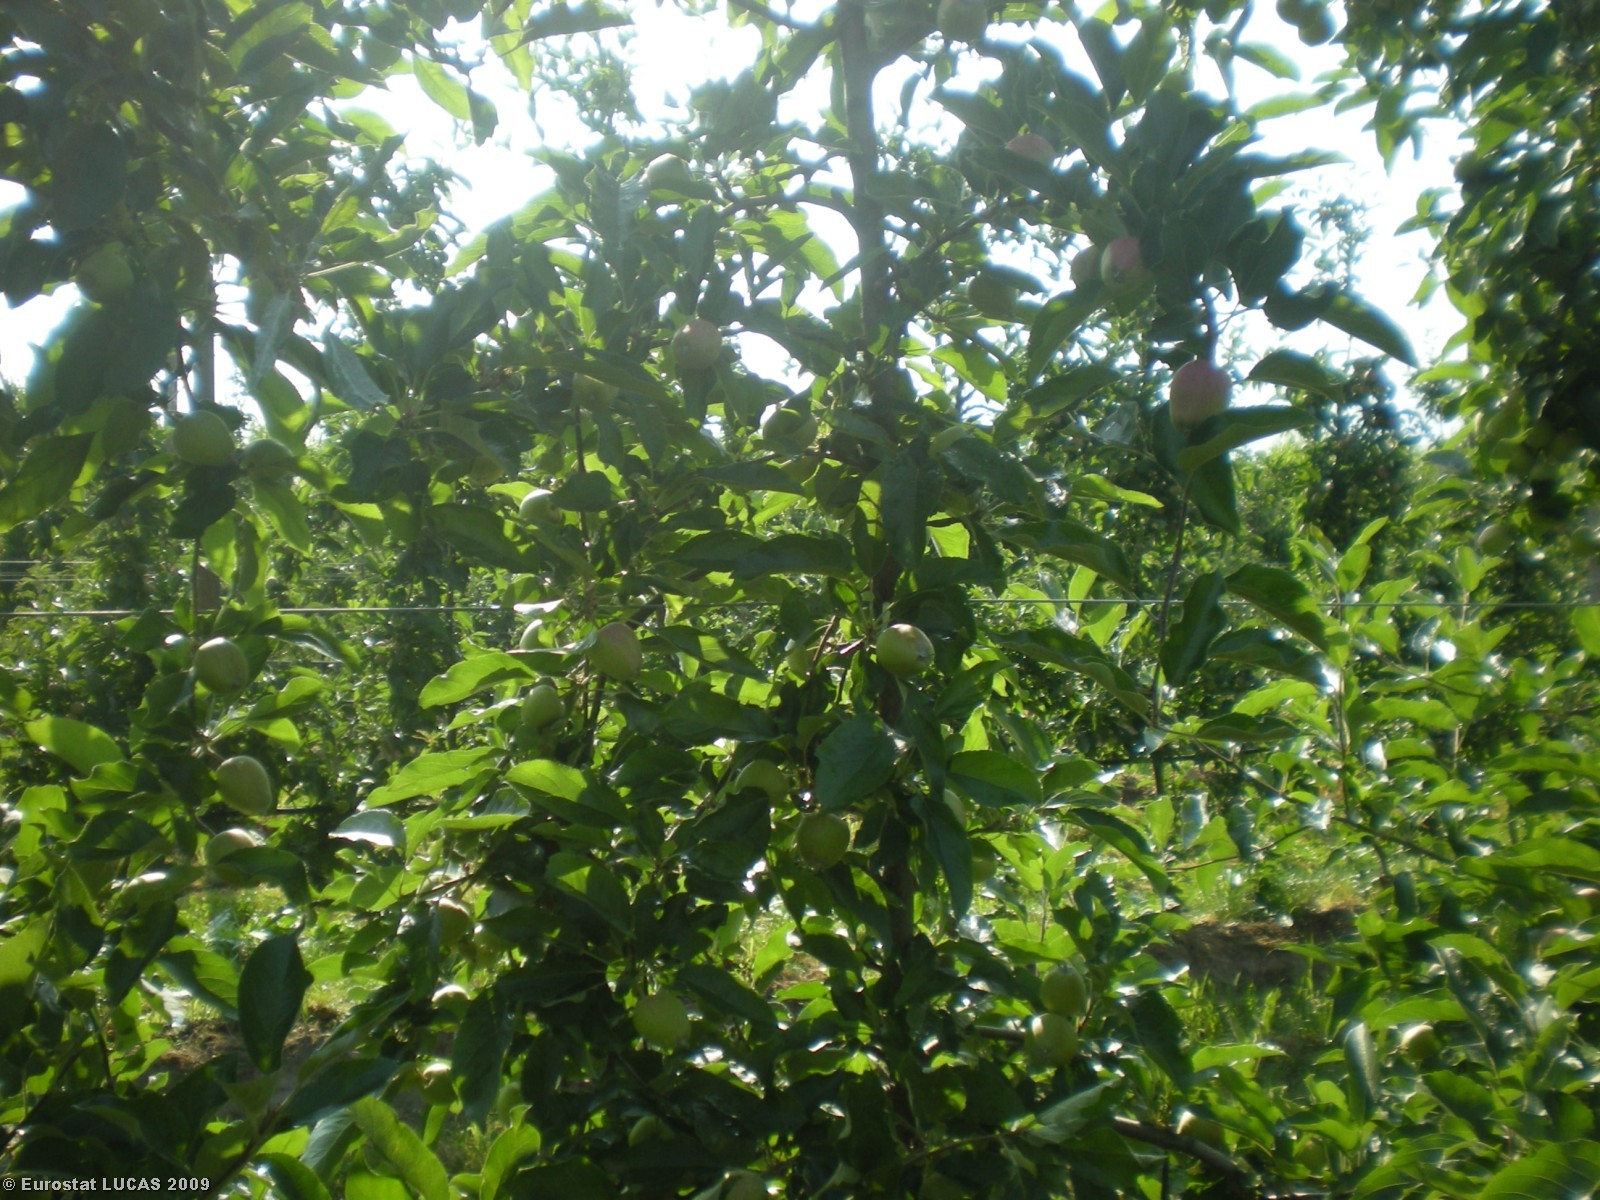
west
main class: Cropland
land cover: Apple fruit
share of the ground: 25 - 50 %
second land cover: Grassland with sparse tree/shrub cover
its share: > 75 %
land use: Agriculture (excluding fallow land and kitchen gardens)
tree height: < 5 m
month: June
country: IT
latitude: 44.6433
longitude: 7.4204
